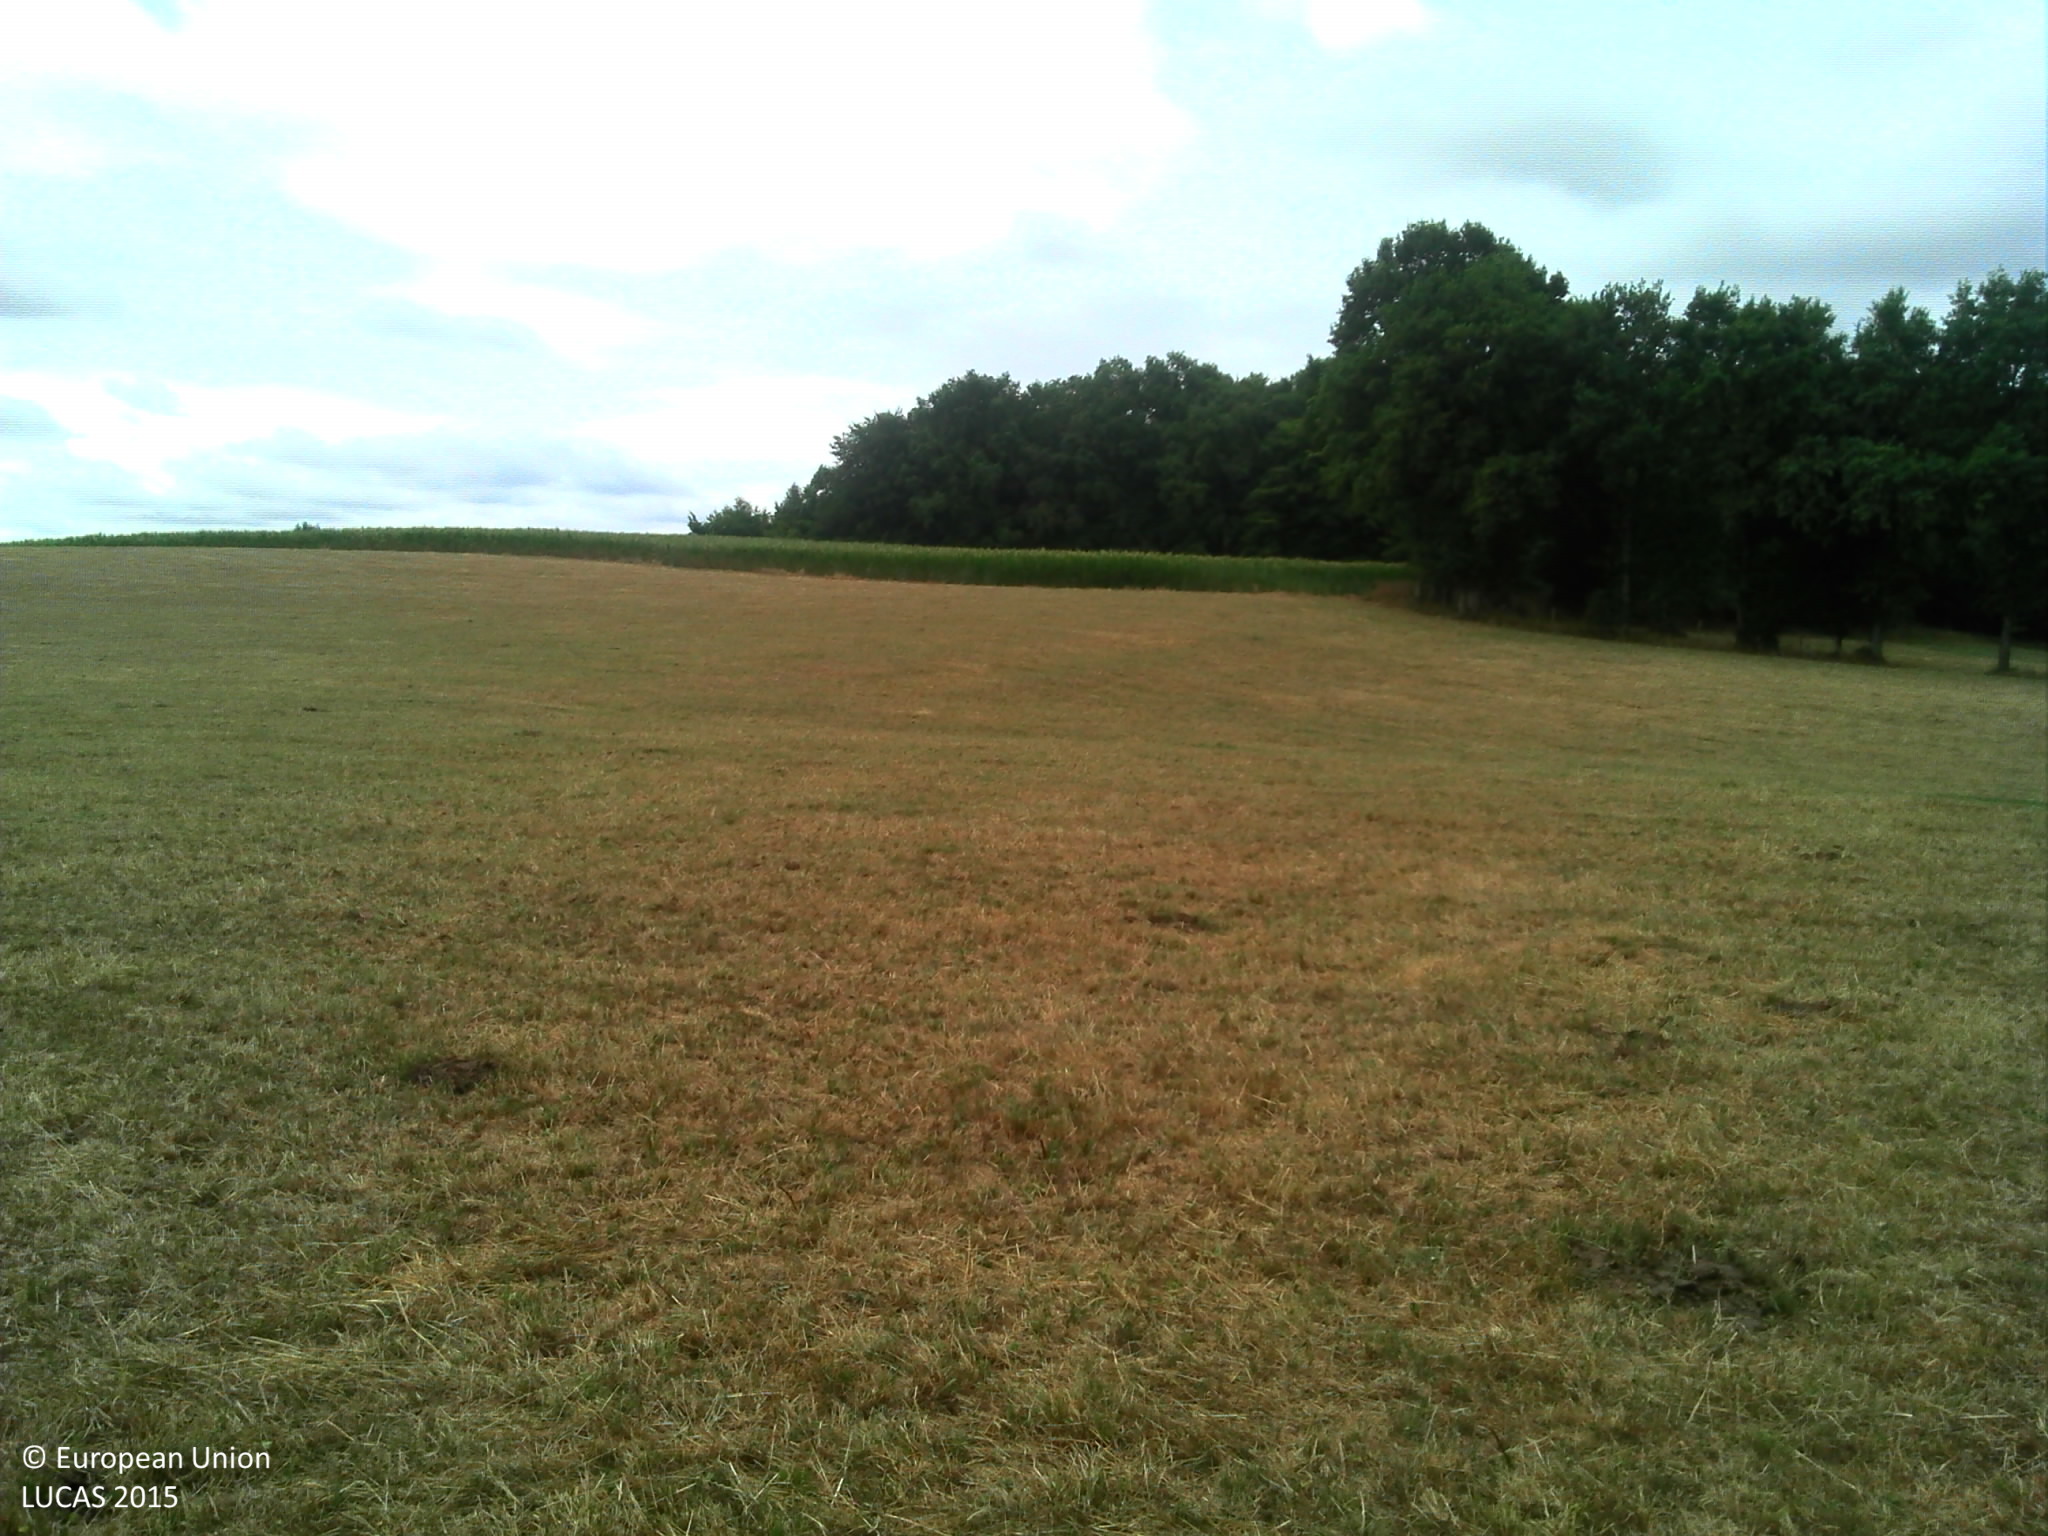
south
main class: Grassland
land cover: Grassland without tree/shrub cover
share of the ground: > 75 %
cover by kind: herbaceous plants 95 %
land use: Agriculture (excluding fallow land and kitchen gardens)
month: July
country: FR
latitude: 45.4736
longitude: 1.3328
